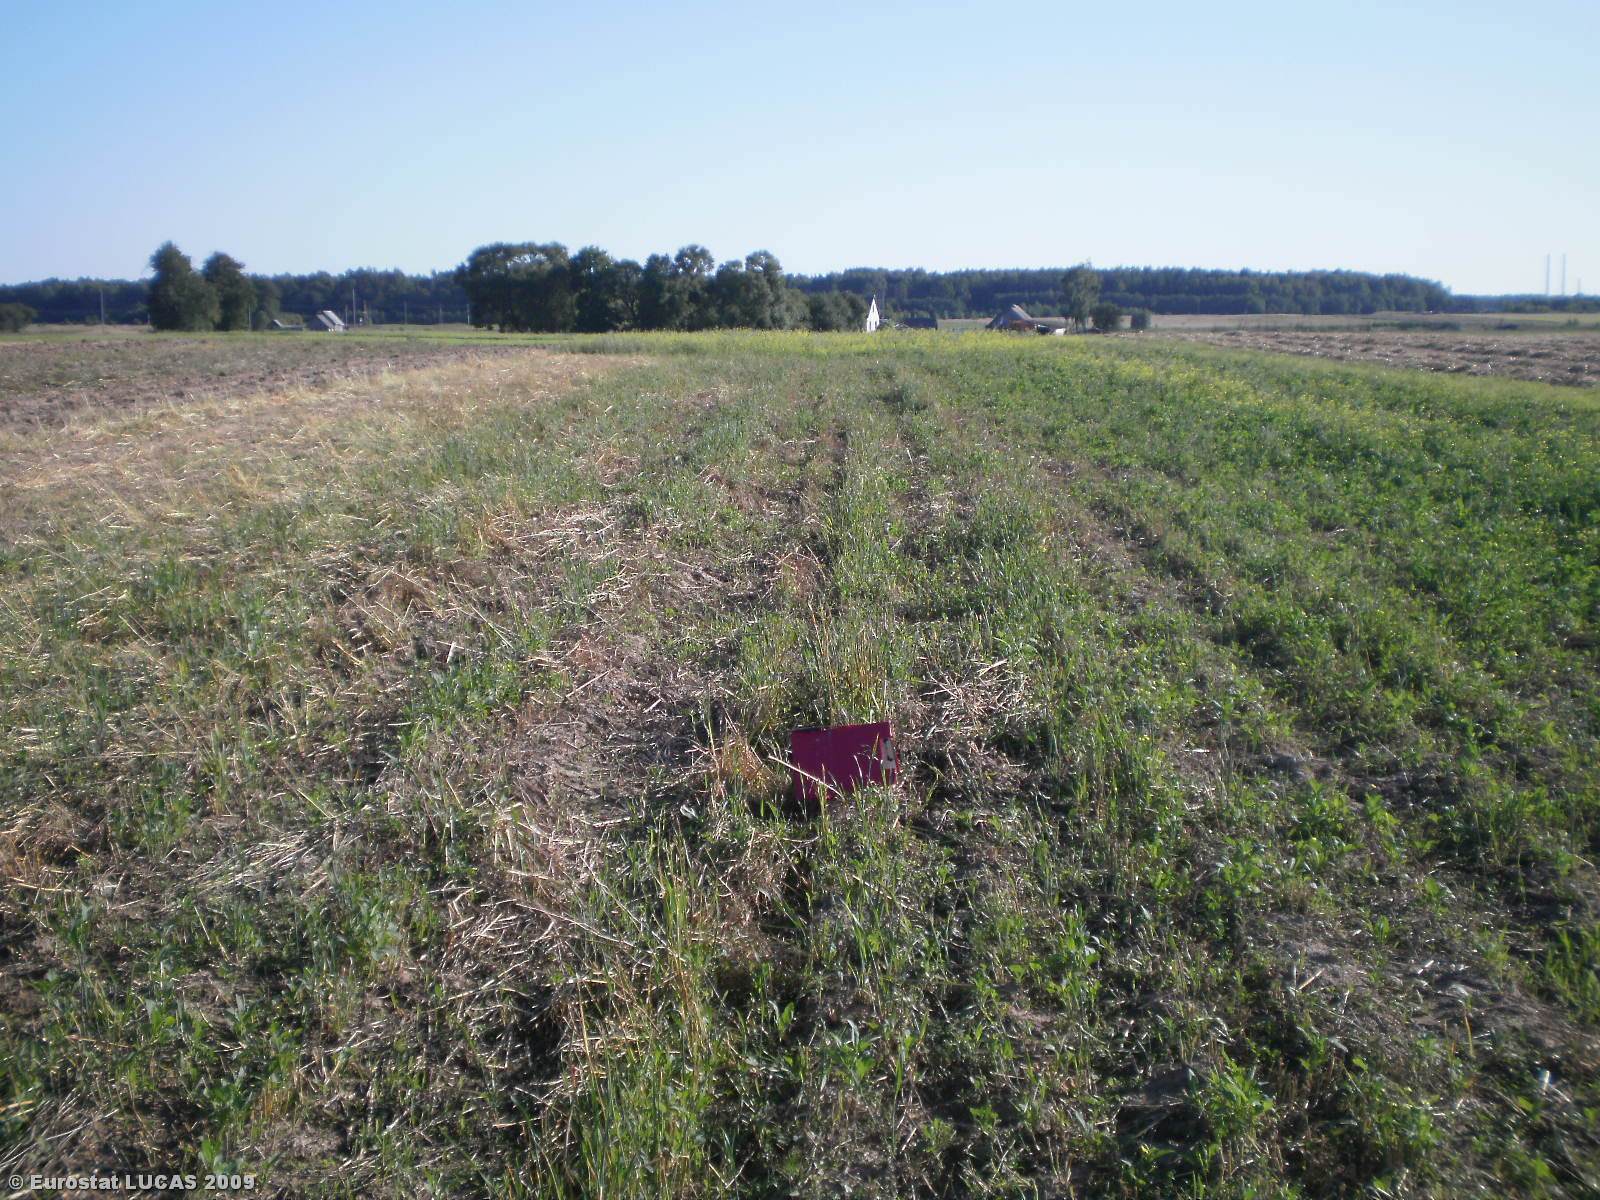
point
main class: Grassland
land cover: Spontaneously vegetated surfaces
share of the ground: > 75 %
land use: Fallow land
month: August
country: LT
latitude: 54.8369
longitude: 24.7275
